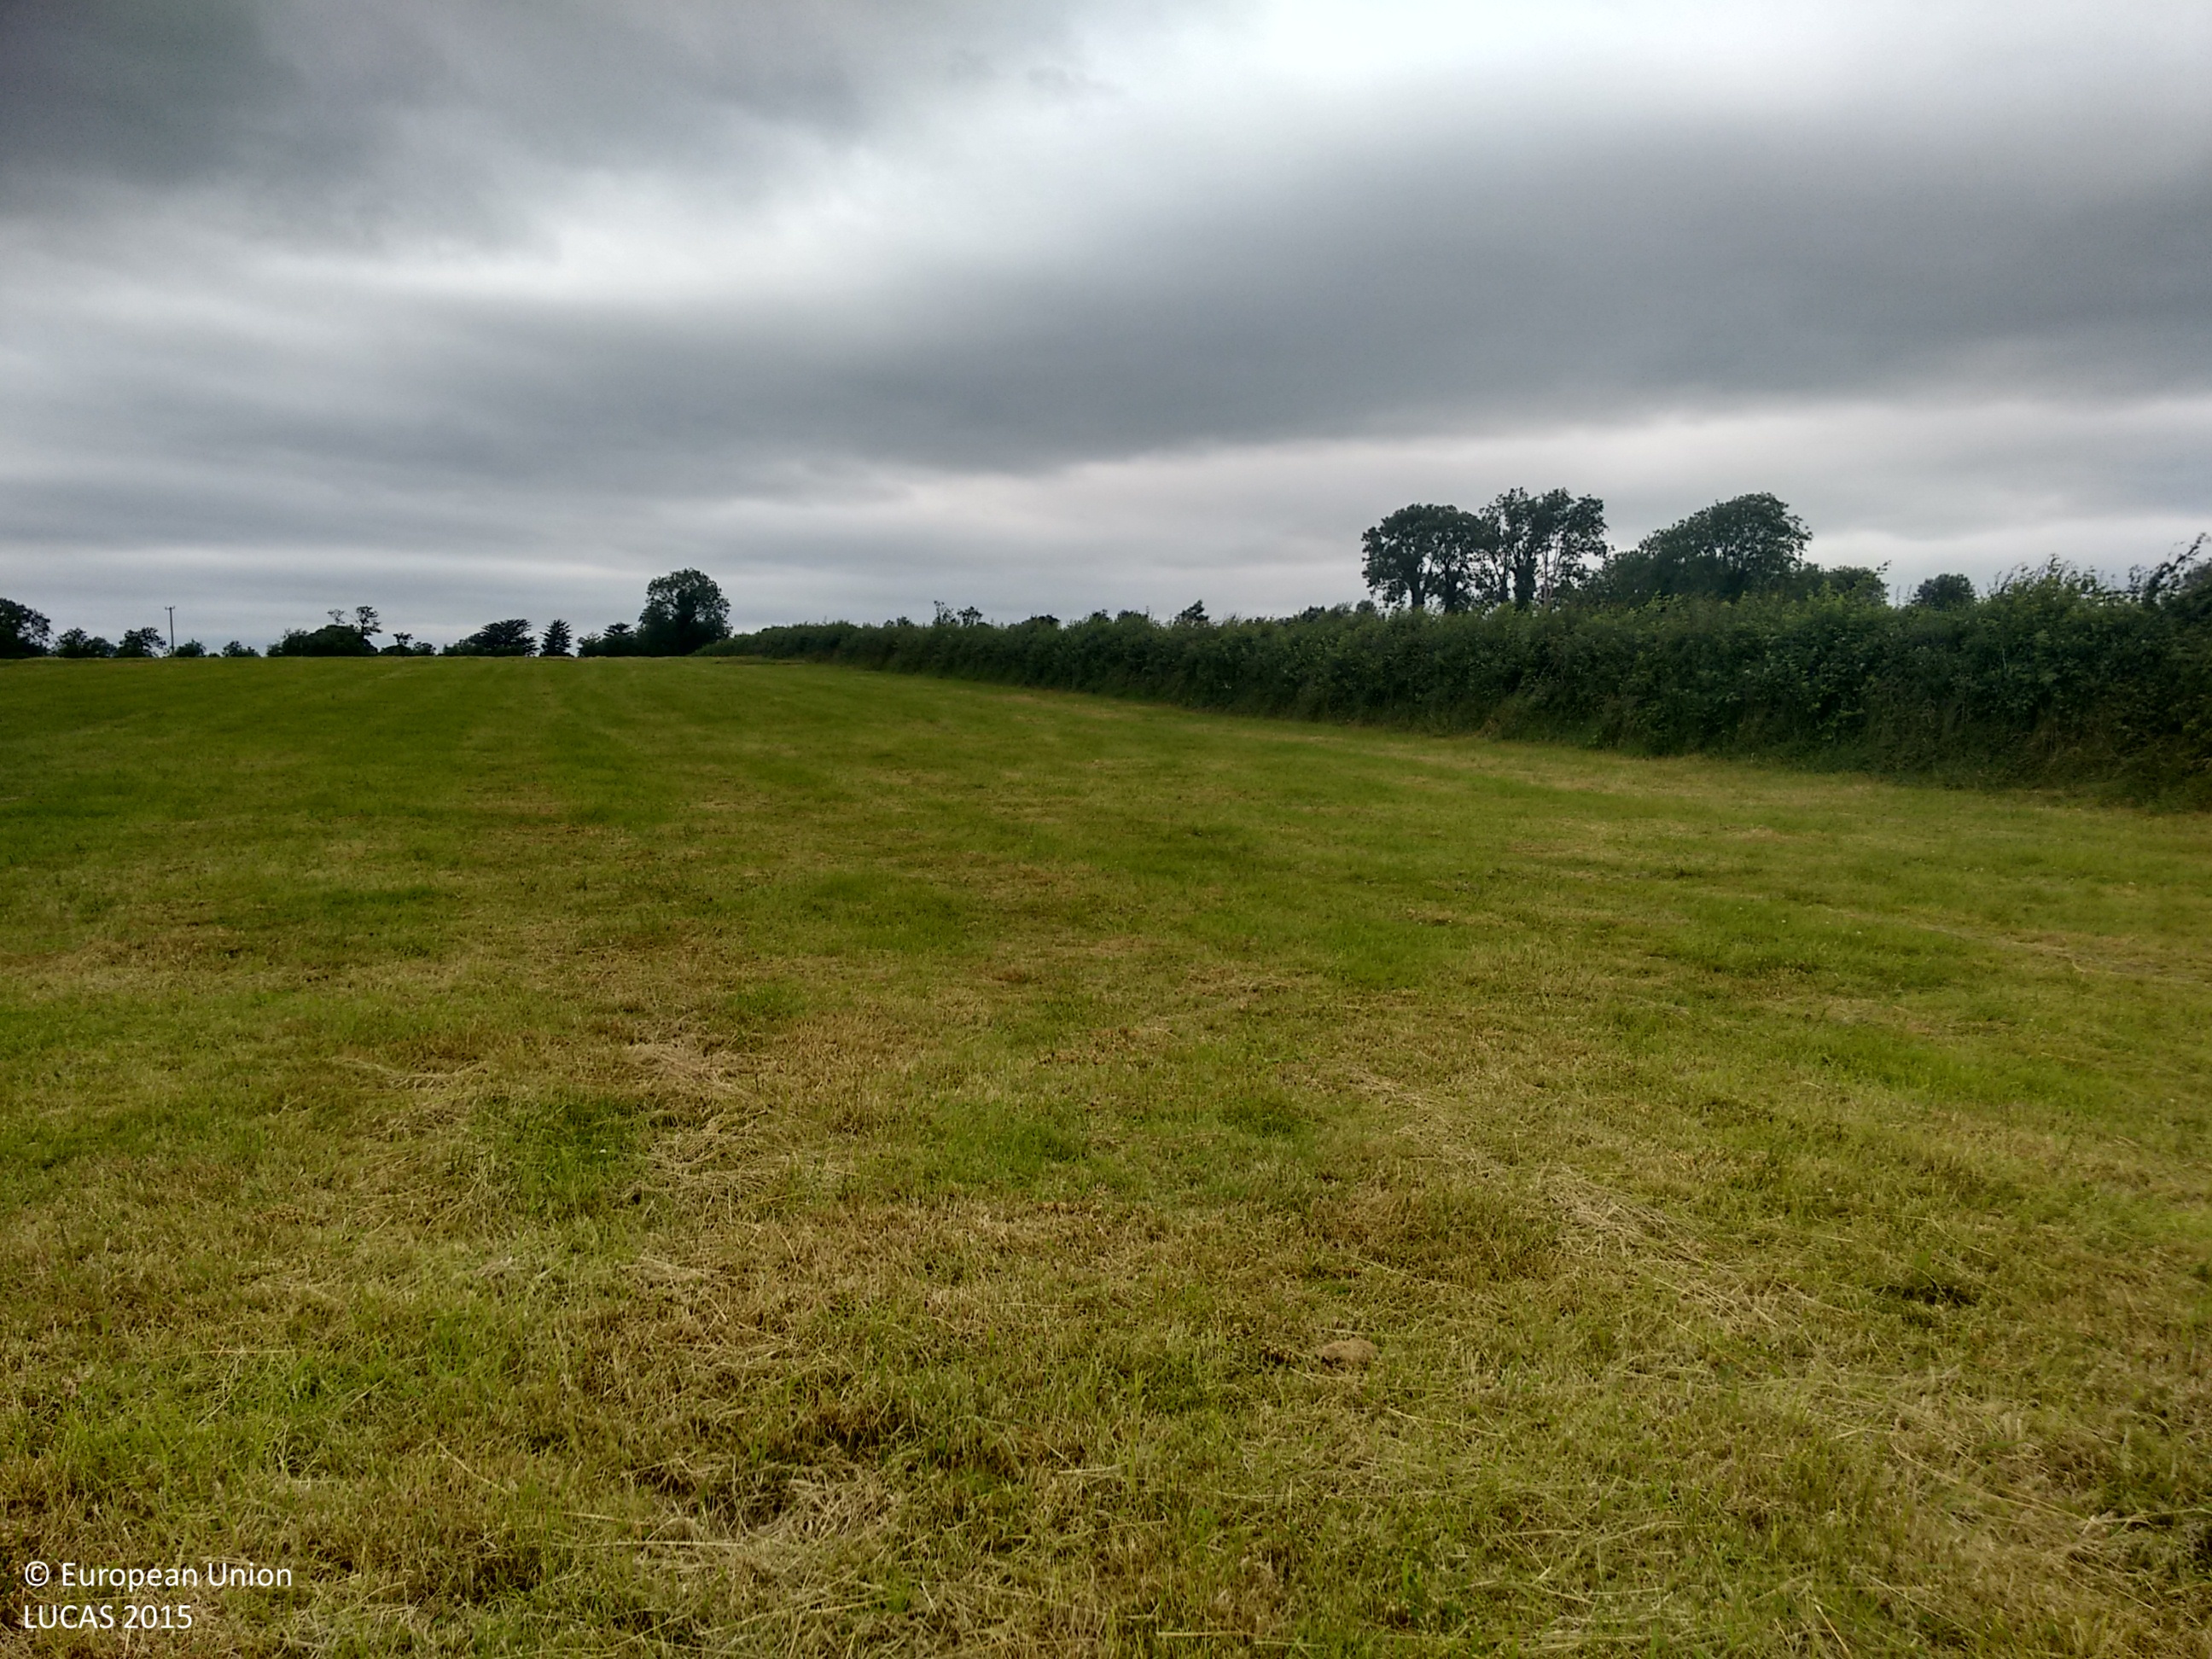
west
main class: Grassland
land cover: Grassland without tree/shrub cover
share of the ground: > 75 %
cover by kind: herbaceous plants 100 %
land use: Agriculture (excluding fallow land and kitchen gardens)
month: July
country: IE
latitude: 53.6621
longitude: -8.1117
